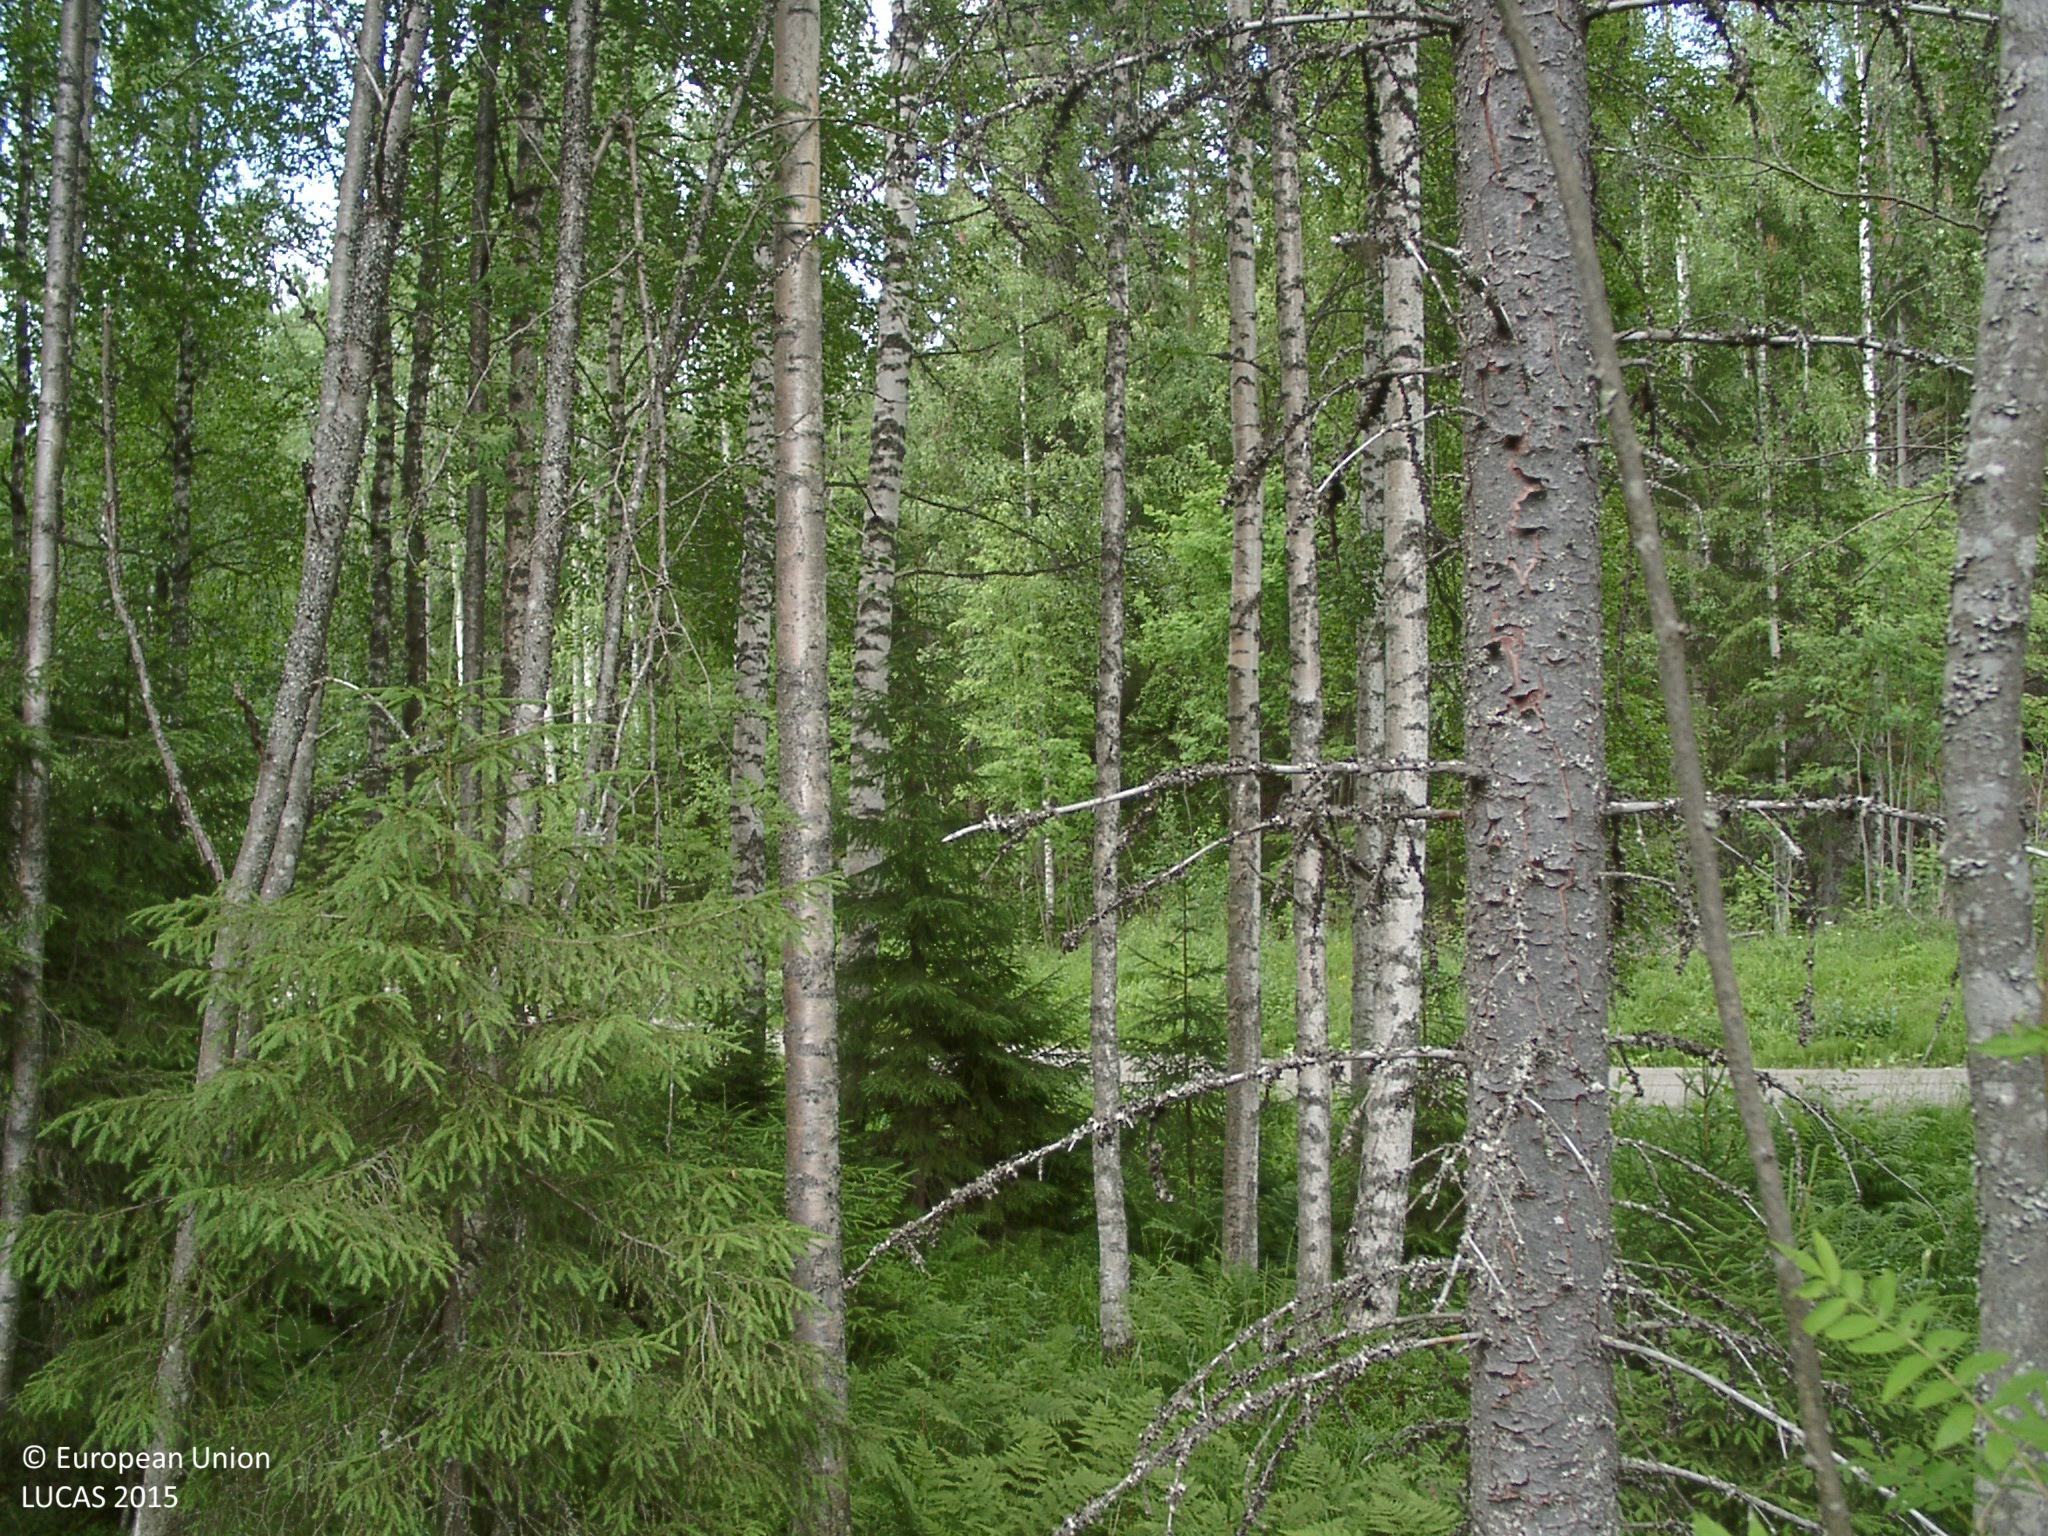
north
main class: Woodland
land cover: Spruce dominated mixed woodland
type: boreal forest
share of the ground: > 75 %
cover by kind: coniferous forest trees 40 %, broadleaved forest trees 35 %, shrubs 15 %, herbaceous plants 10 %
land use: Forestry
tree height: > 5 m
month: July
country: FI
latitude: 61.6501
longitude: 25.1959
